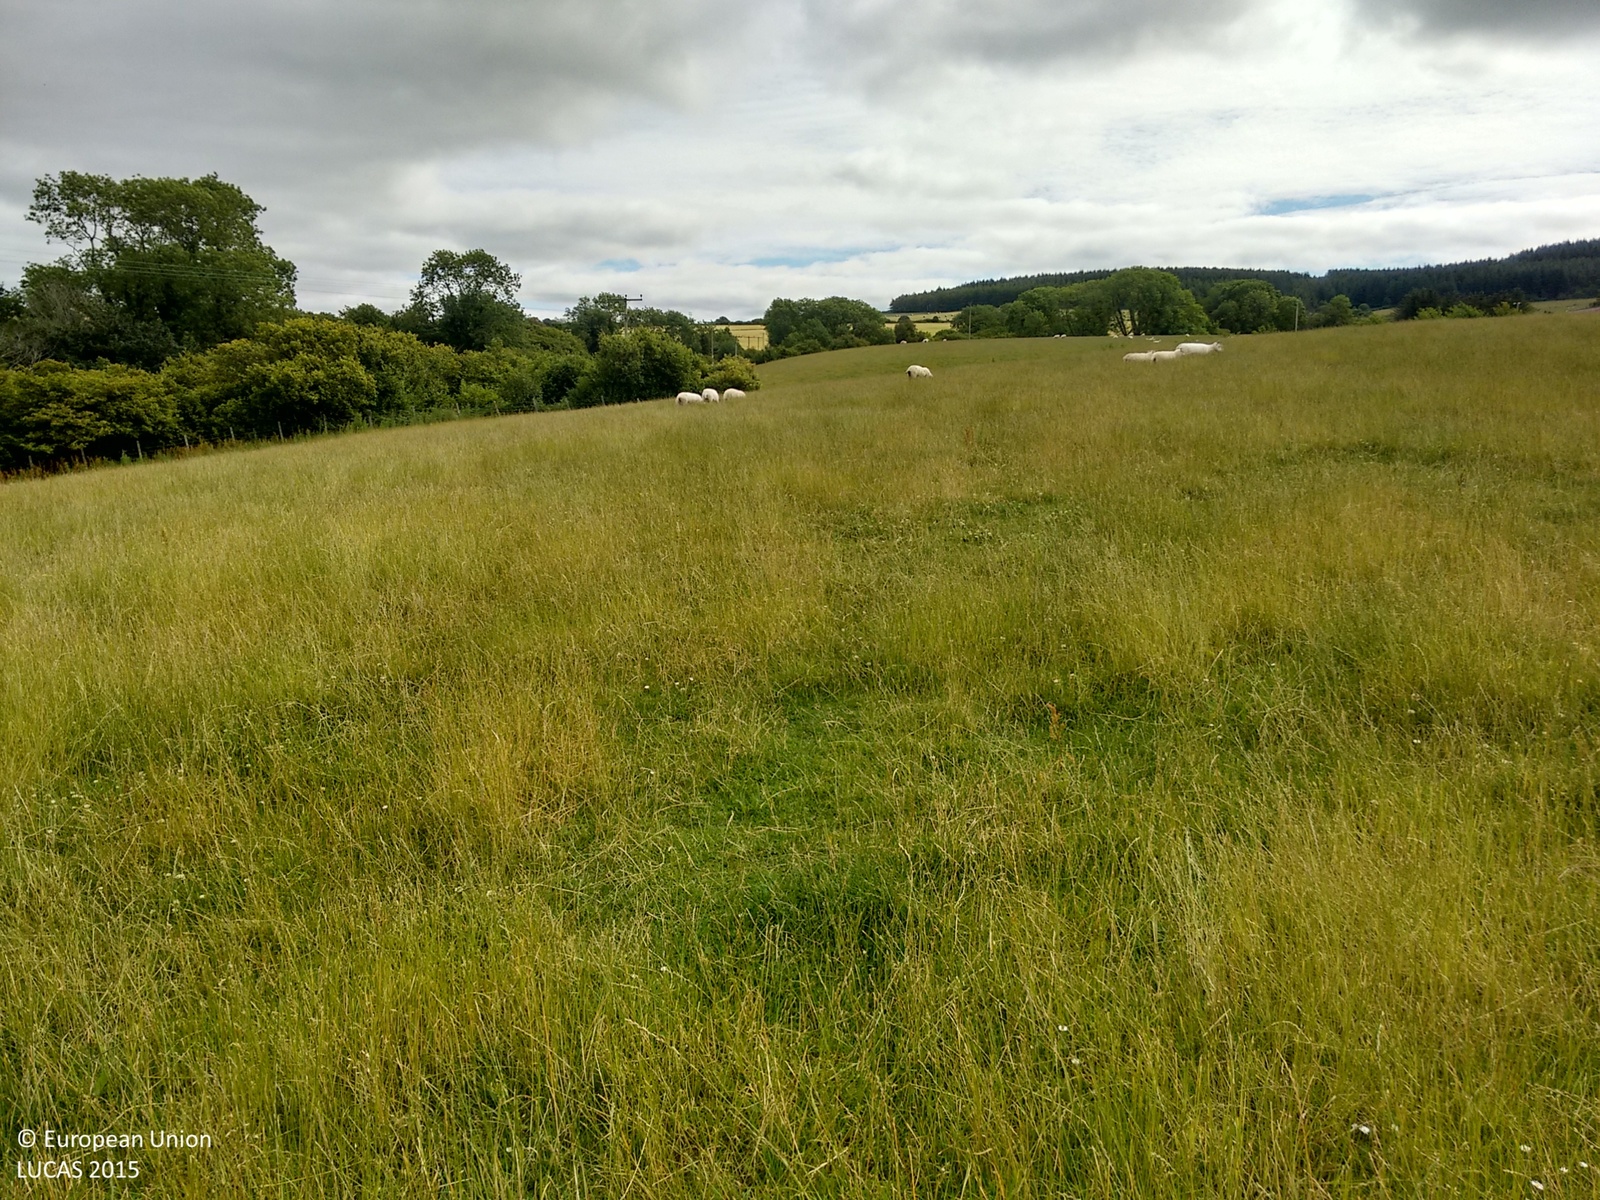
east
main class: Grassland
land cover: Grassland without tree/shrub cover
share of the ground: > 75 %
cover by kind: herbaceous plants 100 %
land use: Agriculture (excluding fallow land and kitchen gardens)
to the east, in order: Grassland without tree/shrub cover; Fences; Managed hedges; Fences; Grassland without tree/shrub cover; Electric lines; Grassland without tree/shrub cover
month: August
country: GB
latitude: 57.6208
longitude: -3.0026
